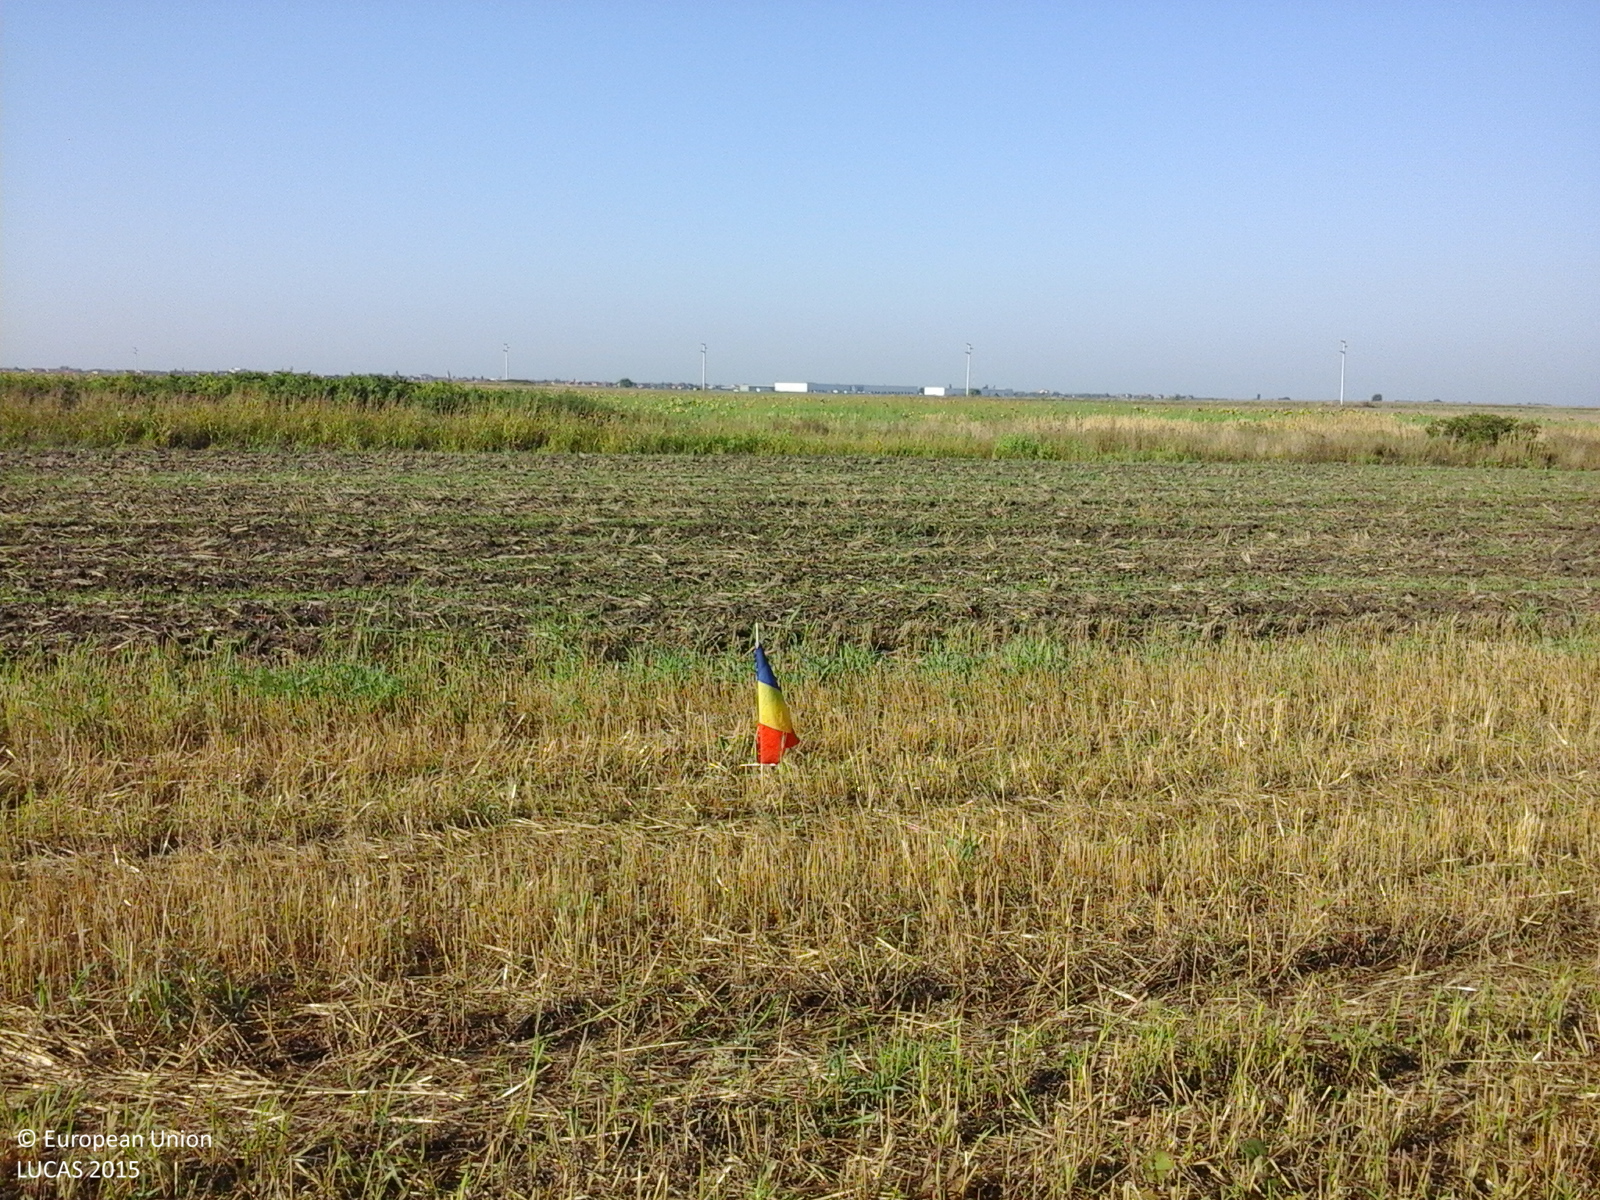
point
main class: Cropland
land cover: Durum wheat
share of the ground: 25 - 50 %
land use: Agriculture (excluding fallow land and kitchen gardens)
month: August
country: RO
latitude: 45.7865
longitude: 21.1305
